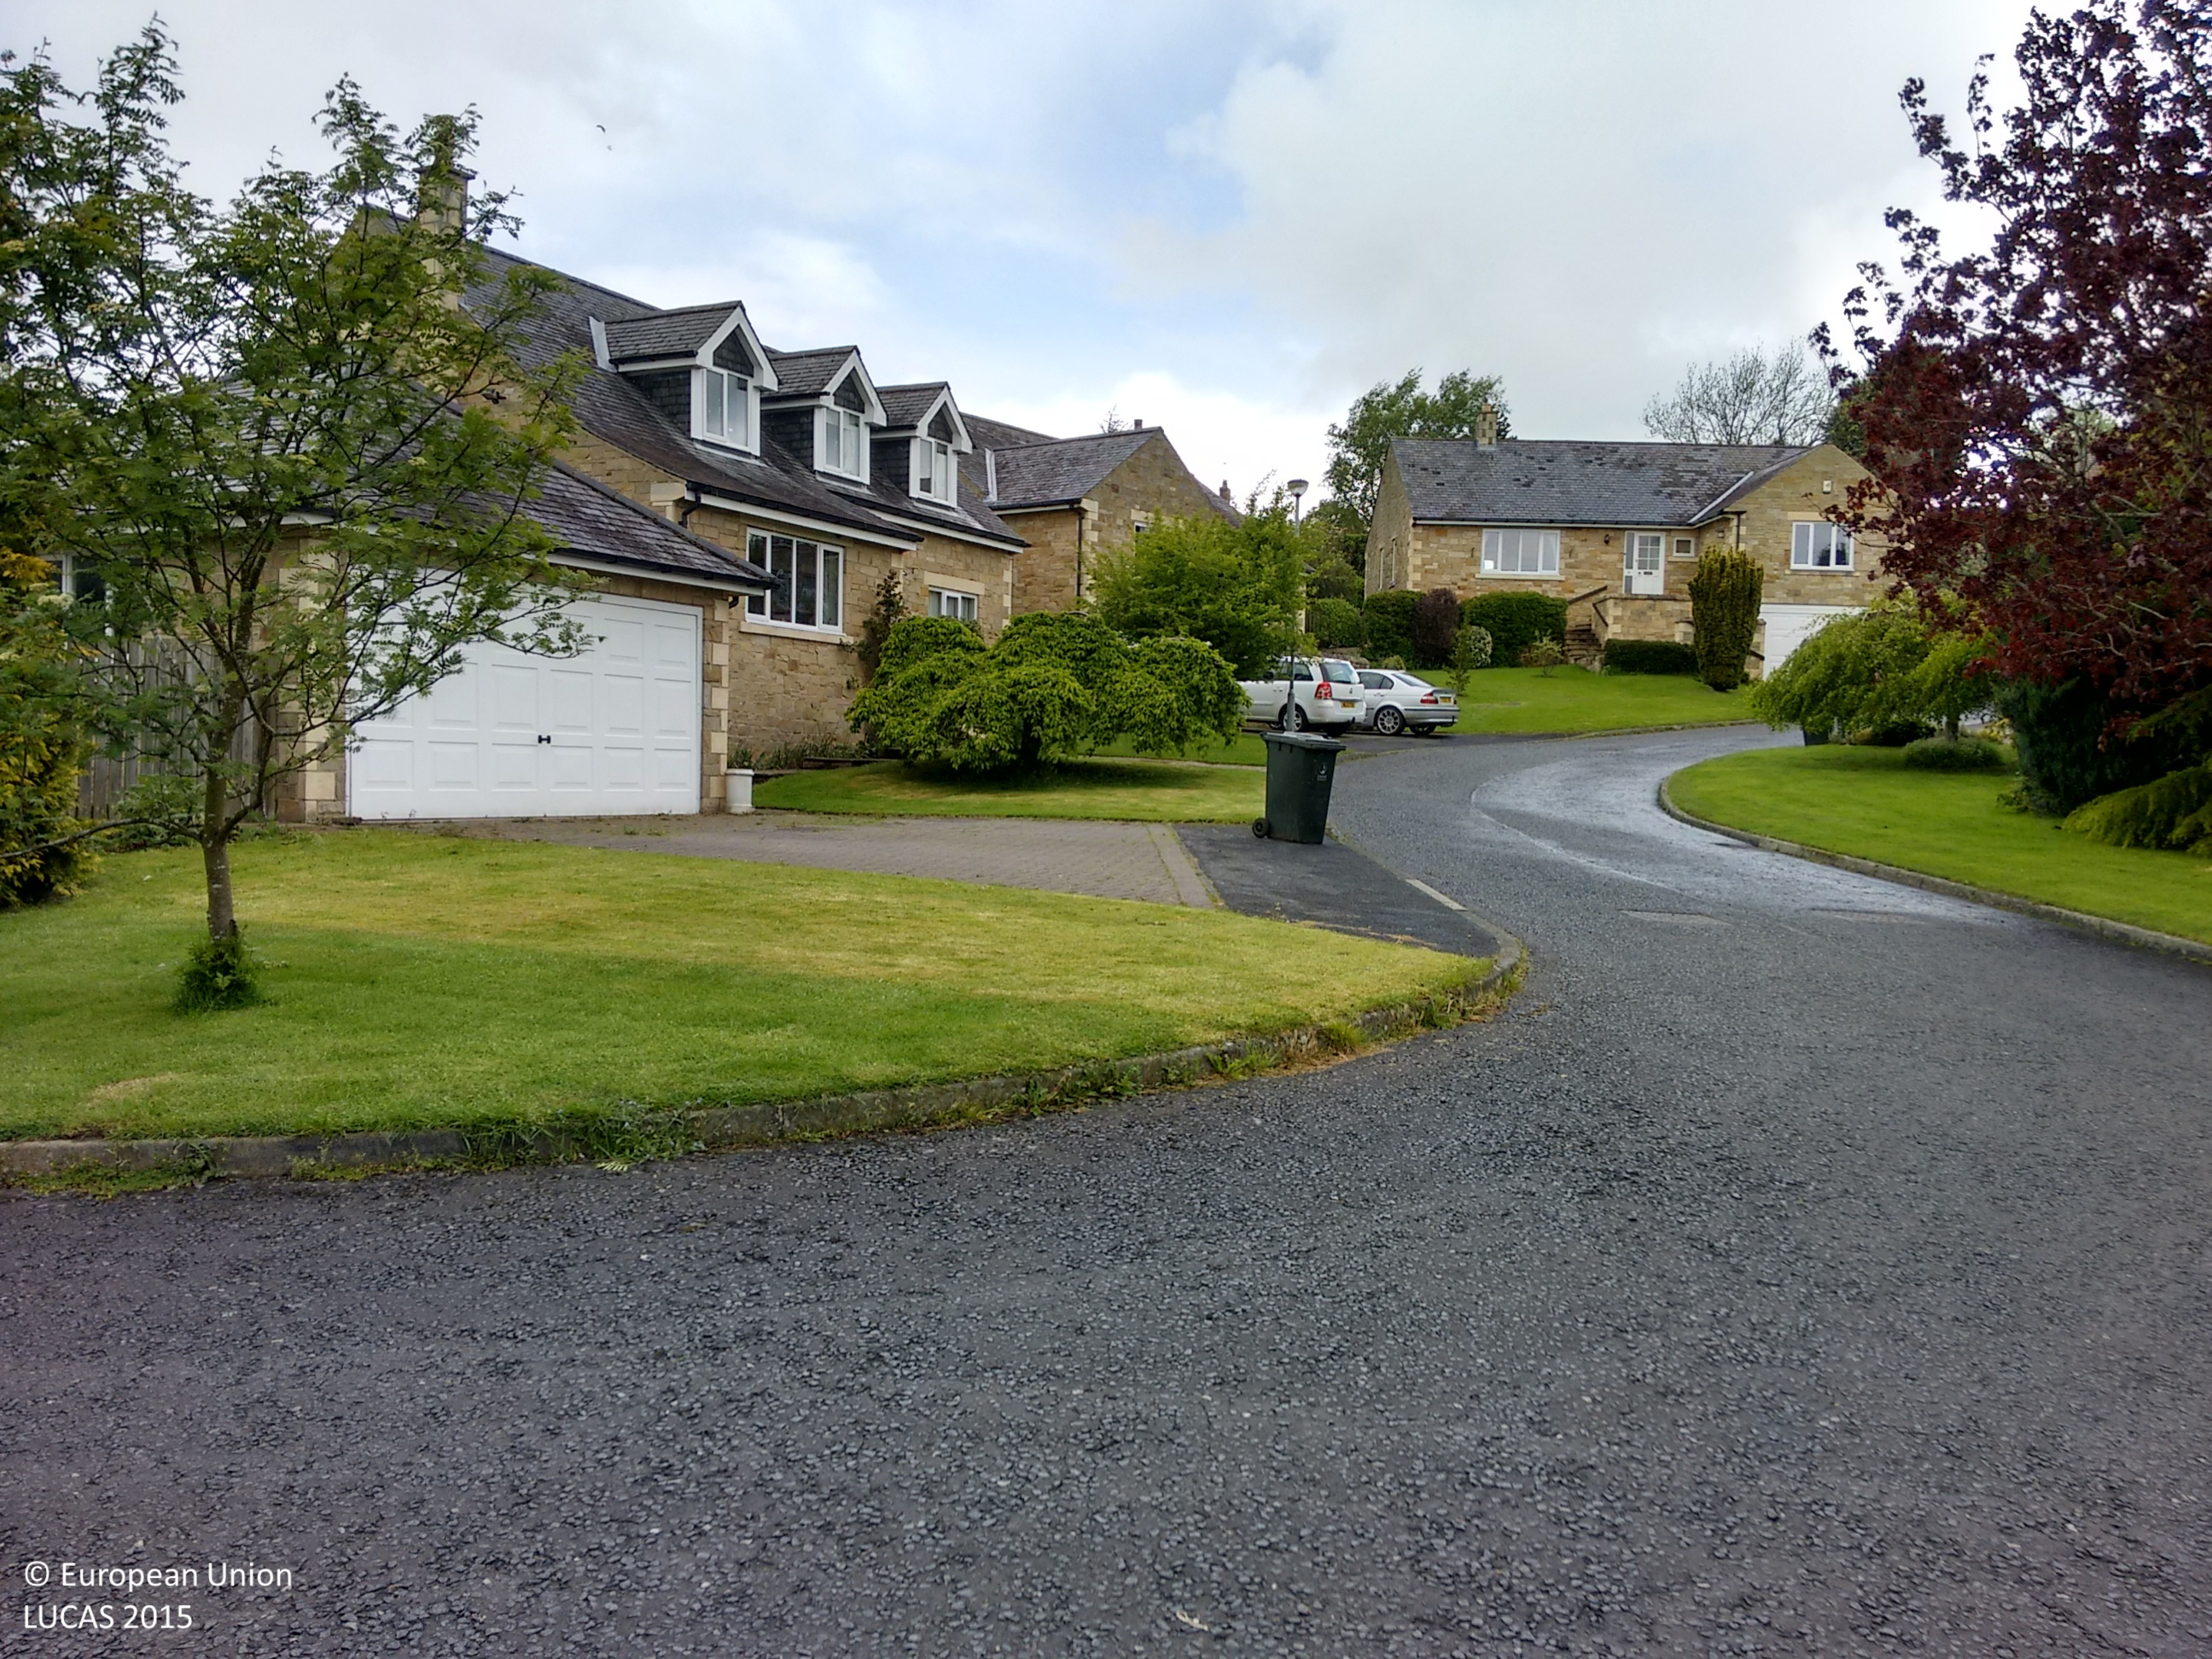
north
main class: Woodland
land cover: Spruce dominated mixed woodland
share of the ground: 50 - 75 %
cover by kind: coniferous forest trees 25 %, broadleaved forest trees 25 %, herbaceous plants 10 %
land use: Residential
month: May
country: GB
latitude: 55.0048
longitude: -2.1743
